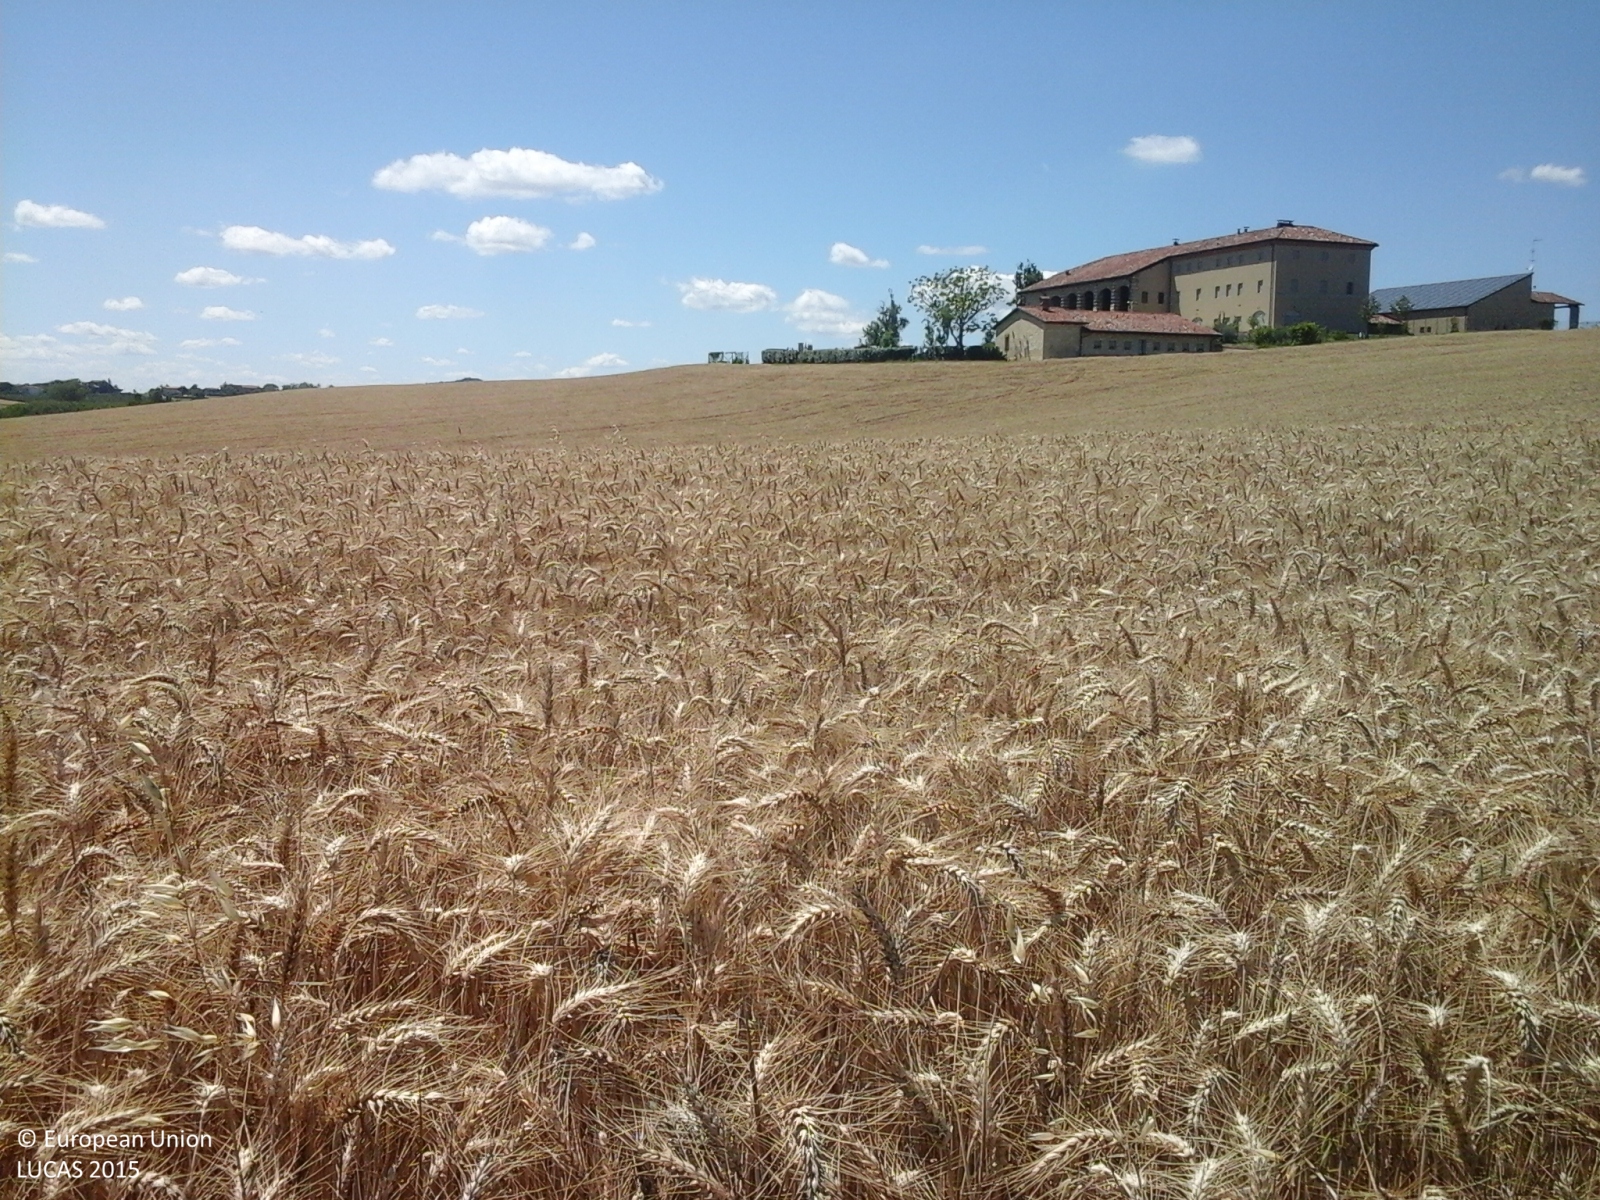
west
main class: Cropland
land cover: Common wheat
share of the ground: > 75 %
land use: Agriculture (excluding fallow land and kitchen gardens)
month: June
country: IT
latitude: 45.0602
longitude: 8.4409
